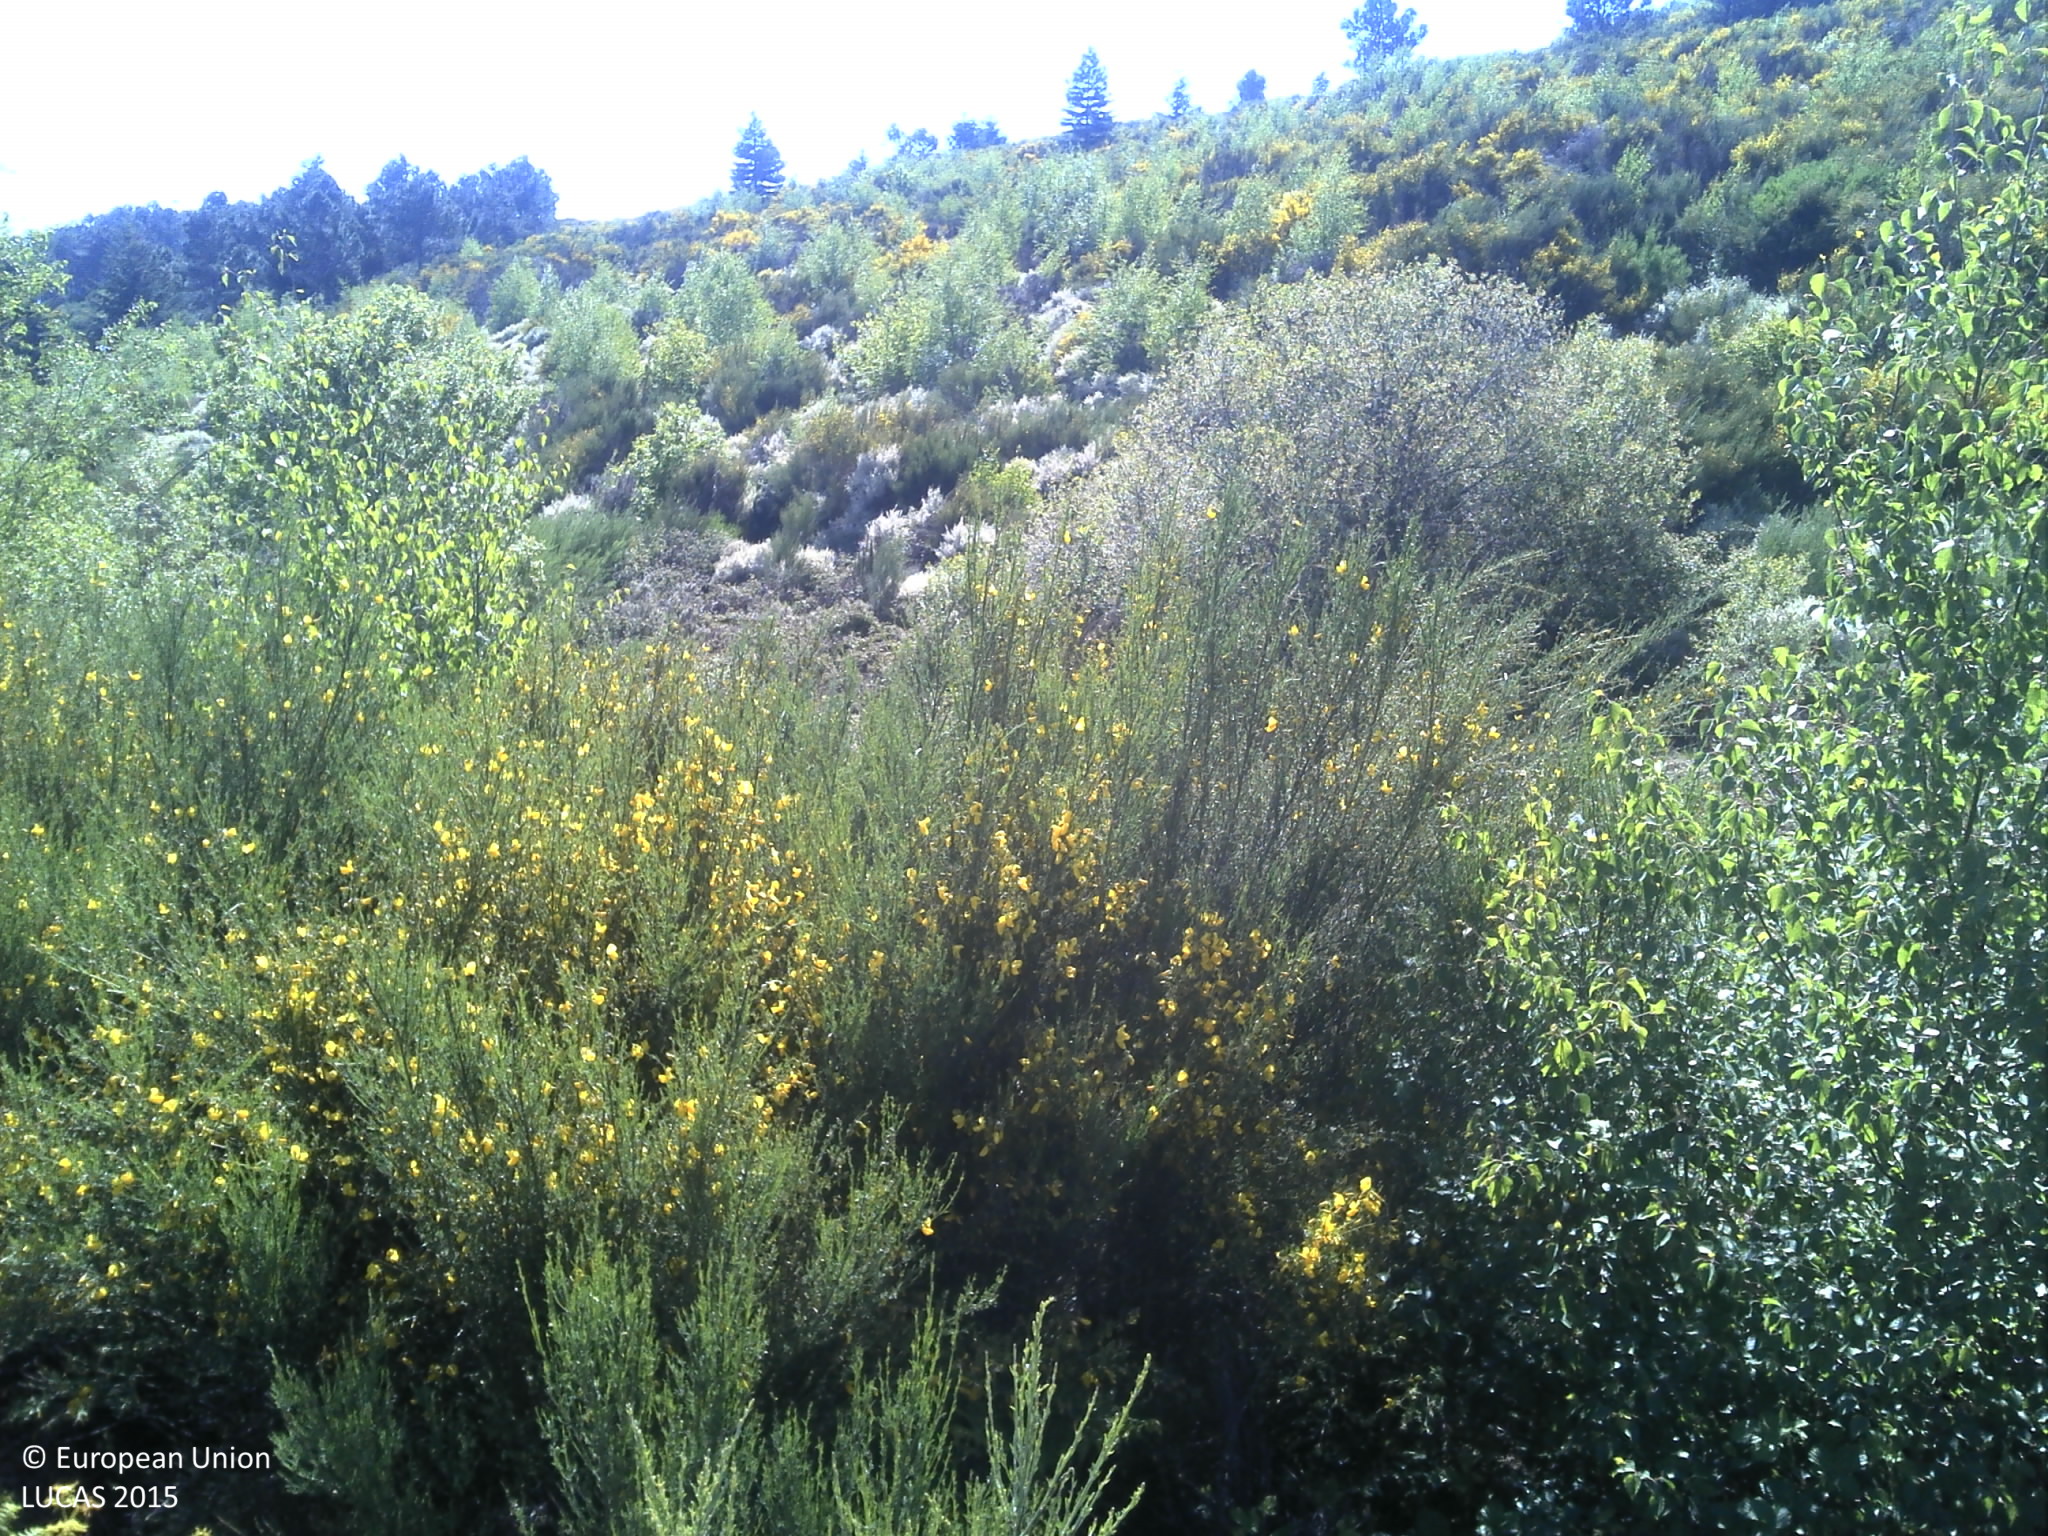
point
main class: Shrubland
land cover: Shrubland without tree cover
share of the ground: > 75 %
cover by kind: shrubs 75 %, herbaceous plants 15 %, unconsolidated bare surface 10 %
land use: Semi-natural and natural areas not in use
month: May
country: PT
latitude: 40.5429
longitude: -7.4071
